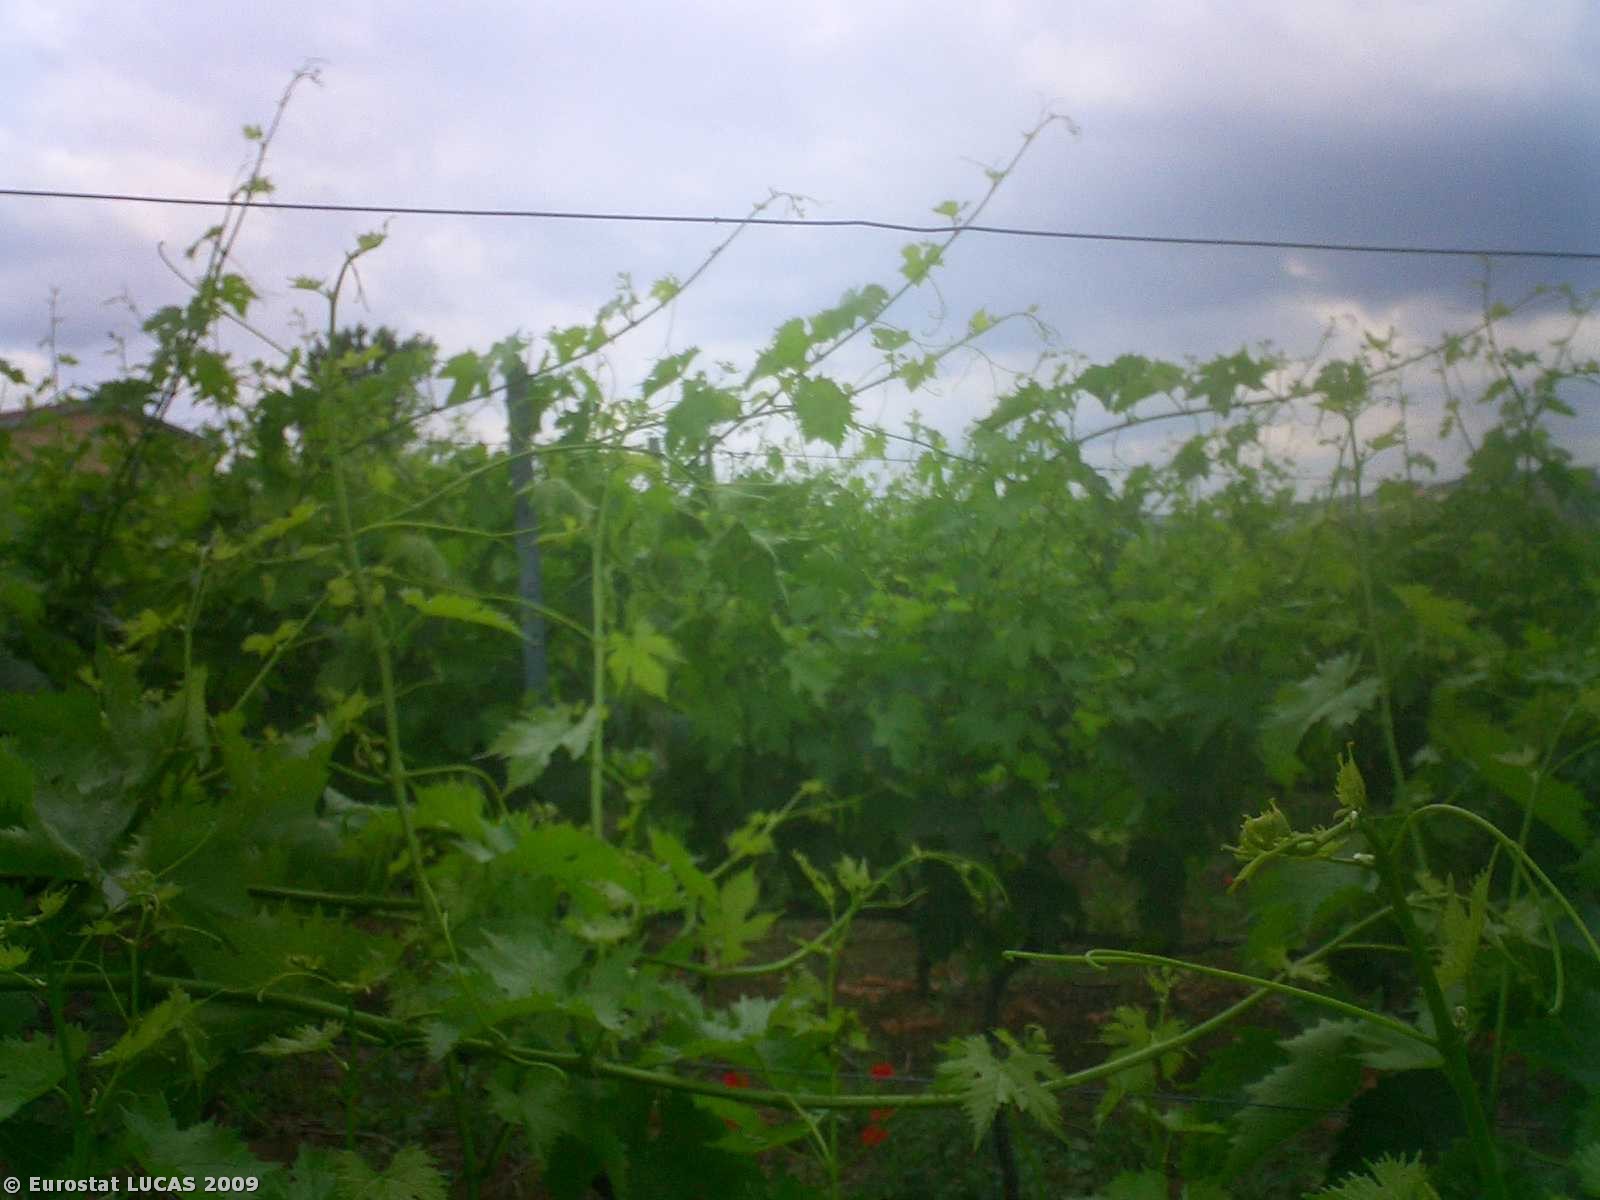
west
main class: Cropland
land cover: Vineyards
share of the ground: 50 - 75 %
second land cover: Grassland without tree/shrub cover
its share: 10 - 25 %
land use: Agriculture (excluding fallow land and kitchen gardens)
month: May
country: IT
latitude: 44.0707
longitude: 12.3793
